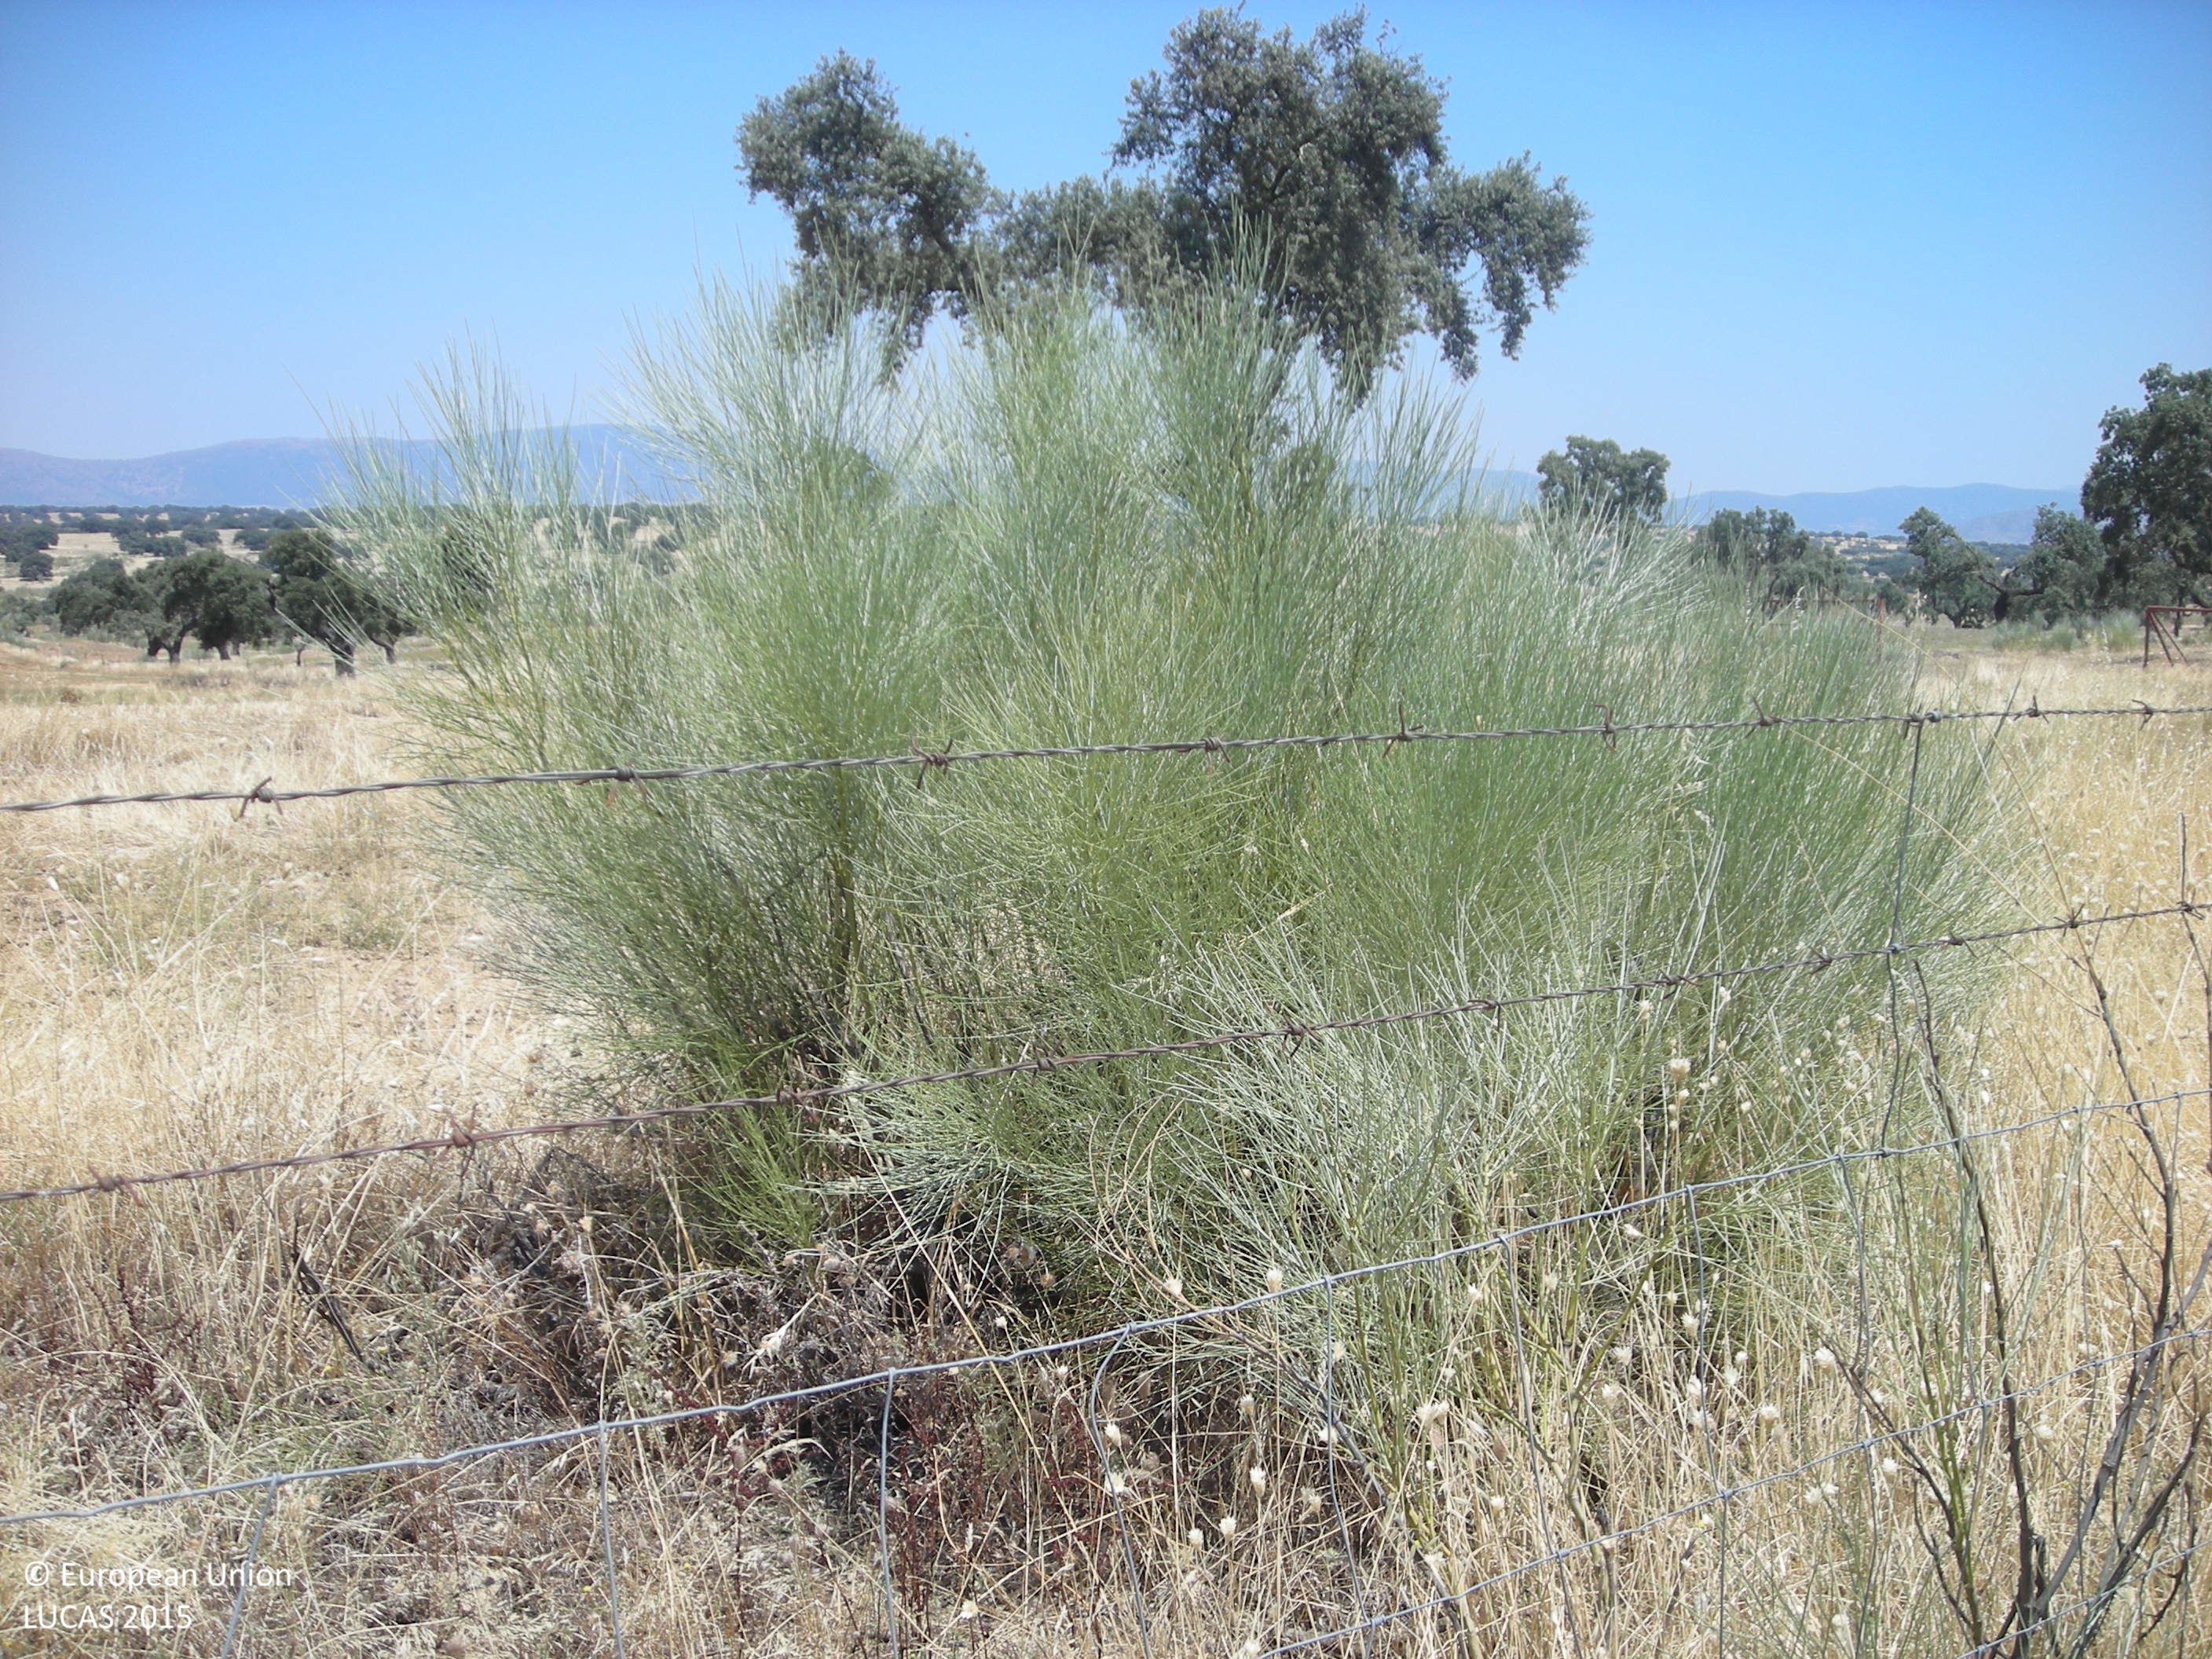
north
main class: Grassland
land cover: Grassland with sparse tree/shrub cover
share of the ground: 50 - 75 %
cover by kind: herbaceous plants 85 %, shrubs 10 %, broadleaved forest trees 5 %
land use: Semi-natural and natural areas not in use
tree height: > 5 m
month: June
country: ES
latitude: 39.2377
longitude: -5.5618
